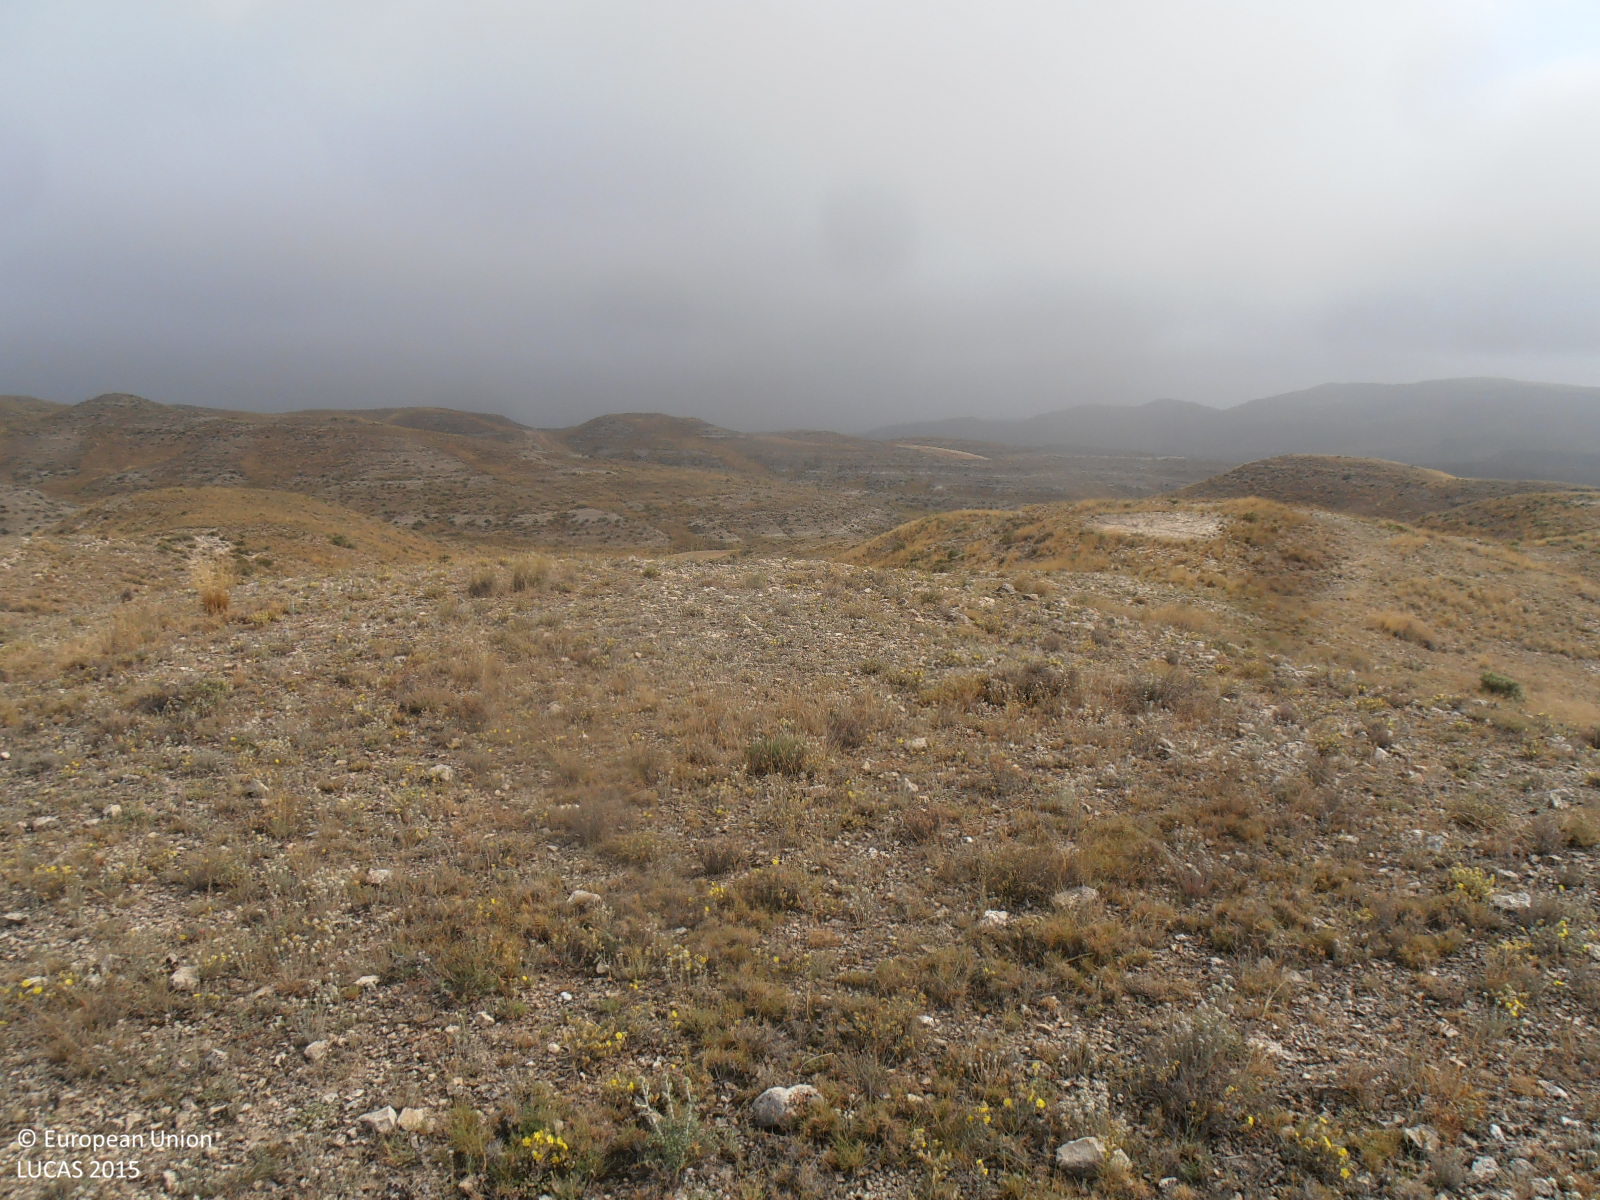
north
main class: Shrubland
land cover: Shrubland without tree cover
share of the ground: > 75 %
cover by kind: shrubs 60 %, herbaceous plants 30 %, consolidated bare surface 10 %
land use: Semi-natural and natural areas not in use
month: June
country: ES
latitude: 41.6247
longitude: -1.2468
